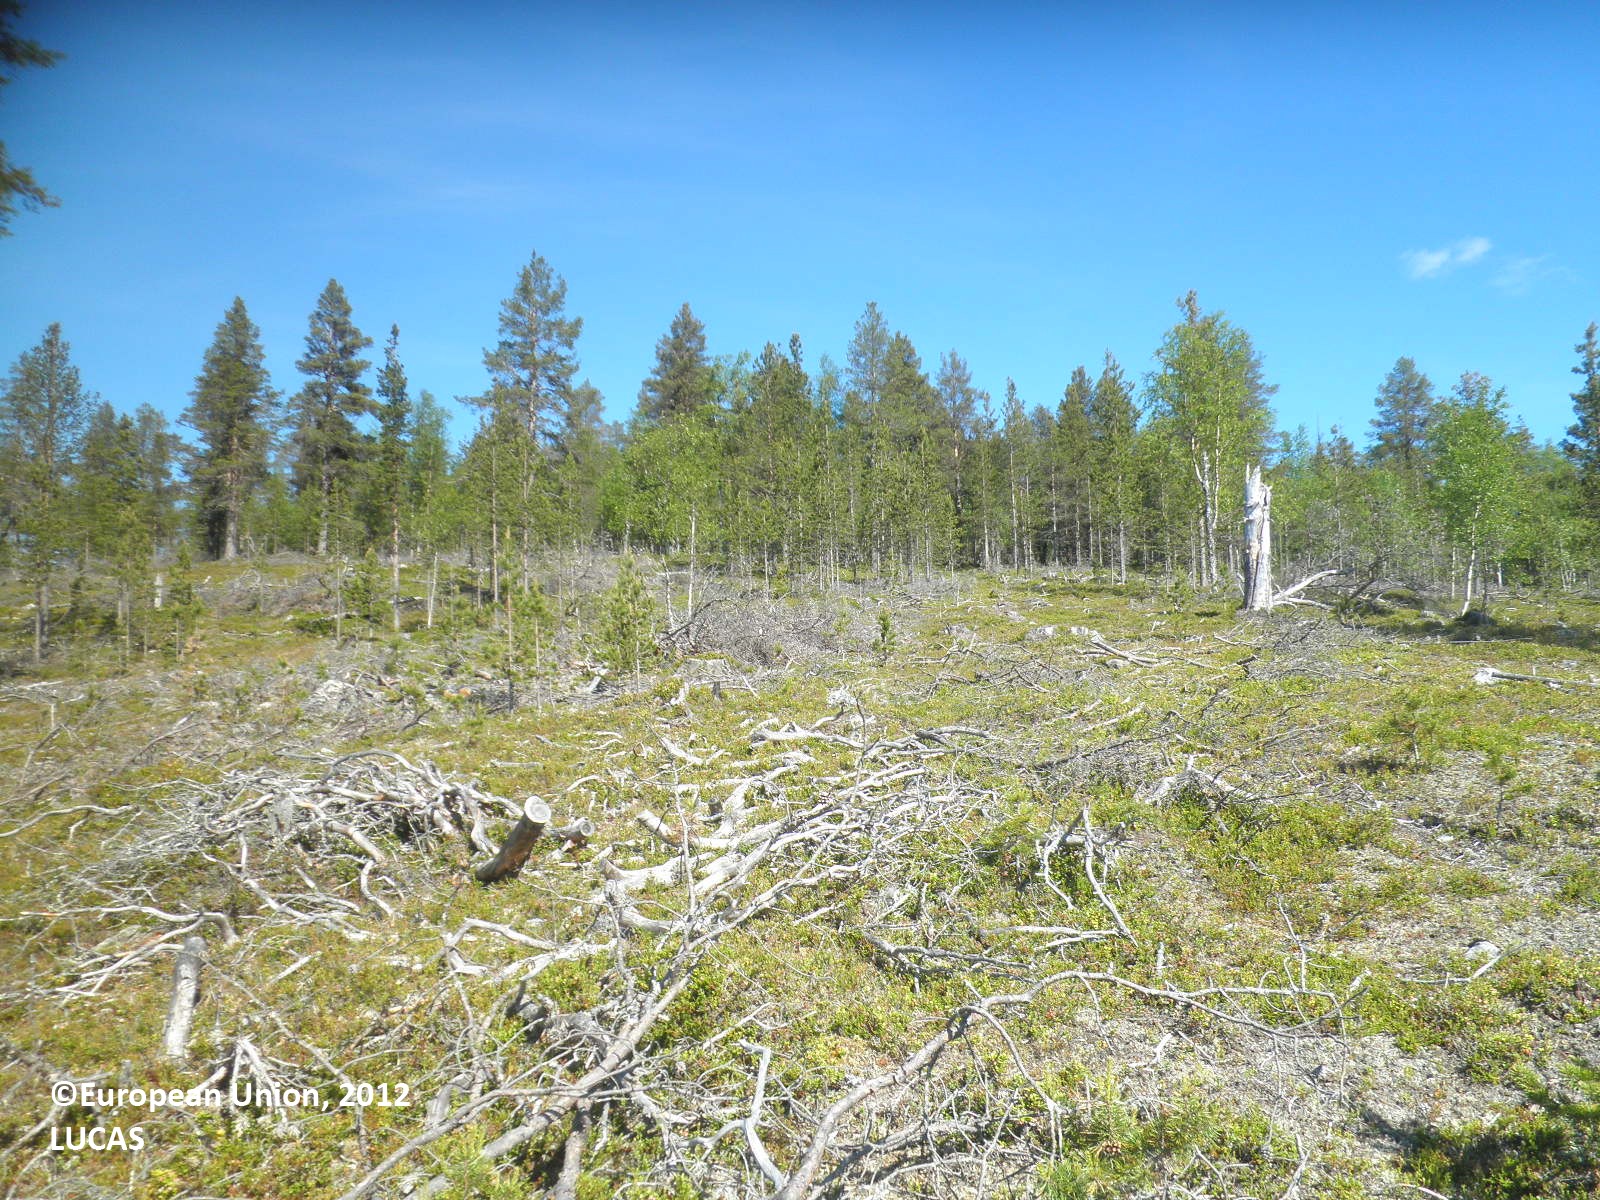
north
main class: Shrubland
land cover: Shrubland with sparse tree cover
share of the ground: 50 - 75 %
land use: Forestry
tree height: < 5 m
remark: Clear cut
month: July
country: FI
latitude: 68.7971
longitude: 26.6271
